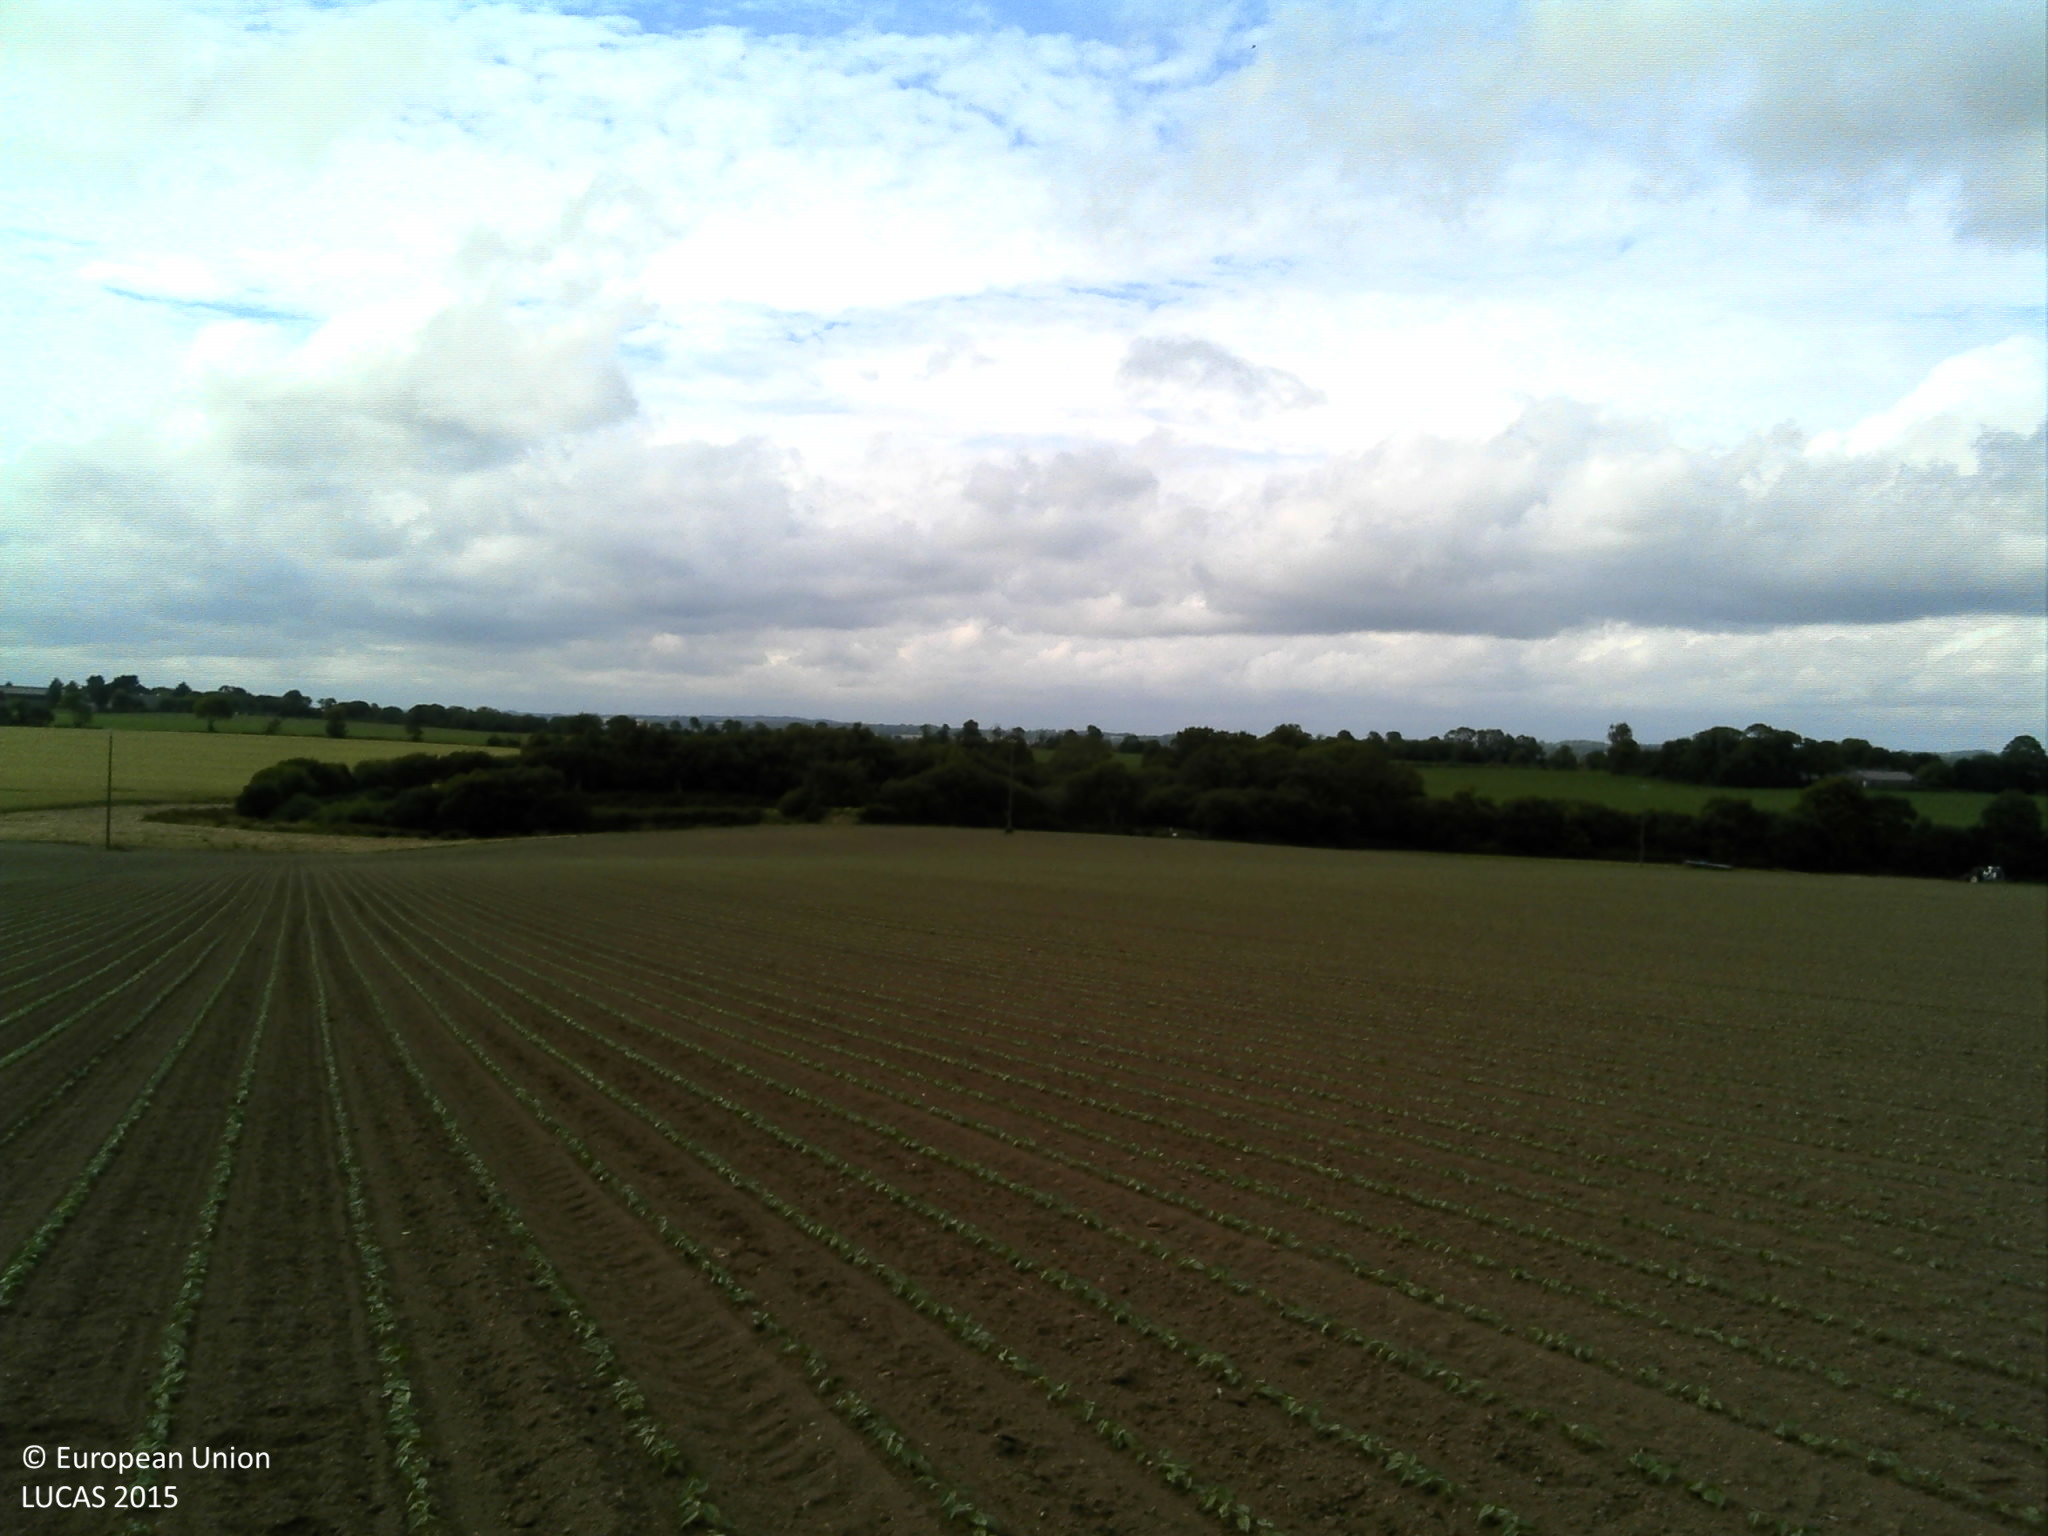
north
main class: Cropland
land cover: Other fresh vegetables
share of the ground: < 10 %
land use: Agriculture (excluding fallow land and kitchen gardens)
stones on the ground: 10 - 25 %
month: June
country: FR
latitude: 47.9079
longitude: -3.5768
